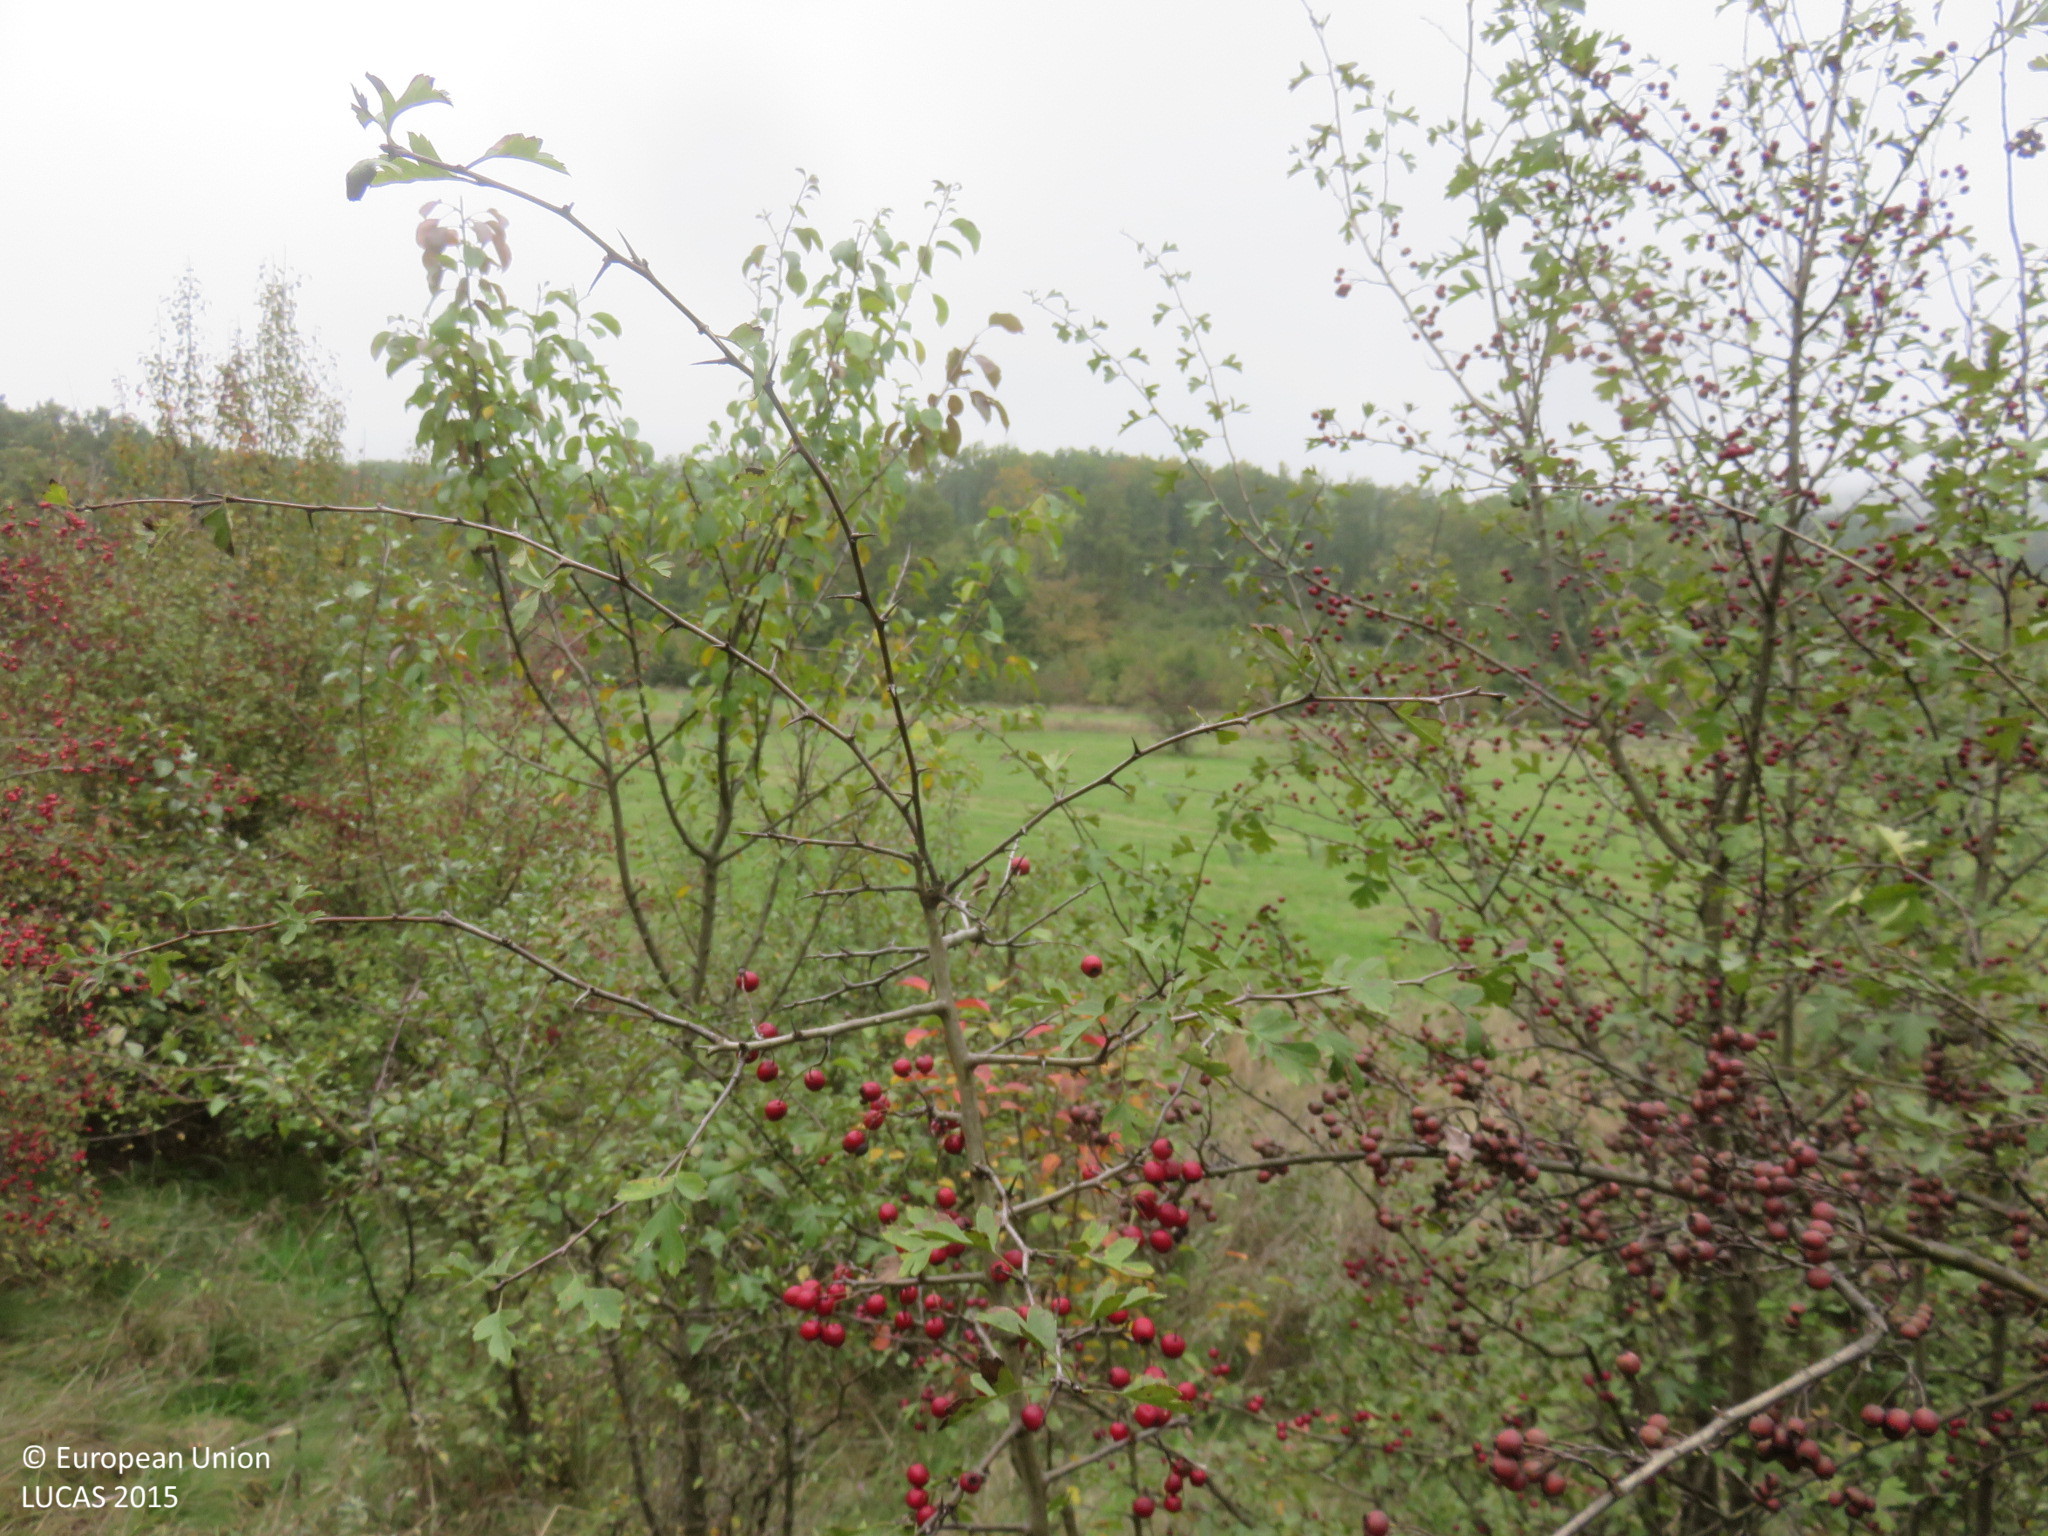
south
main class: Shrubland
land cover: Shrubland with sparse tree cover
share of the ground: > 75 %
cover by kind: shrubs 90 %, broadleaved forest trees 5 %, herbaceous plants 5 %
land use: Semi-natural and natural areas not in use
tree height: < 5 m
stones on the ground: < 10 %
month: October
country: BG
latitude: 43.0353
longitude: 25.2289
